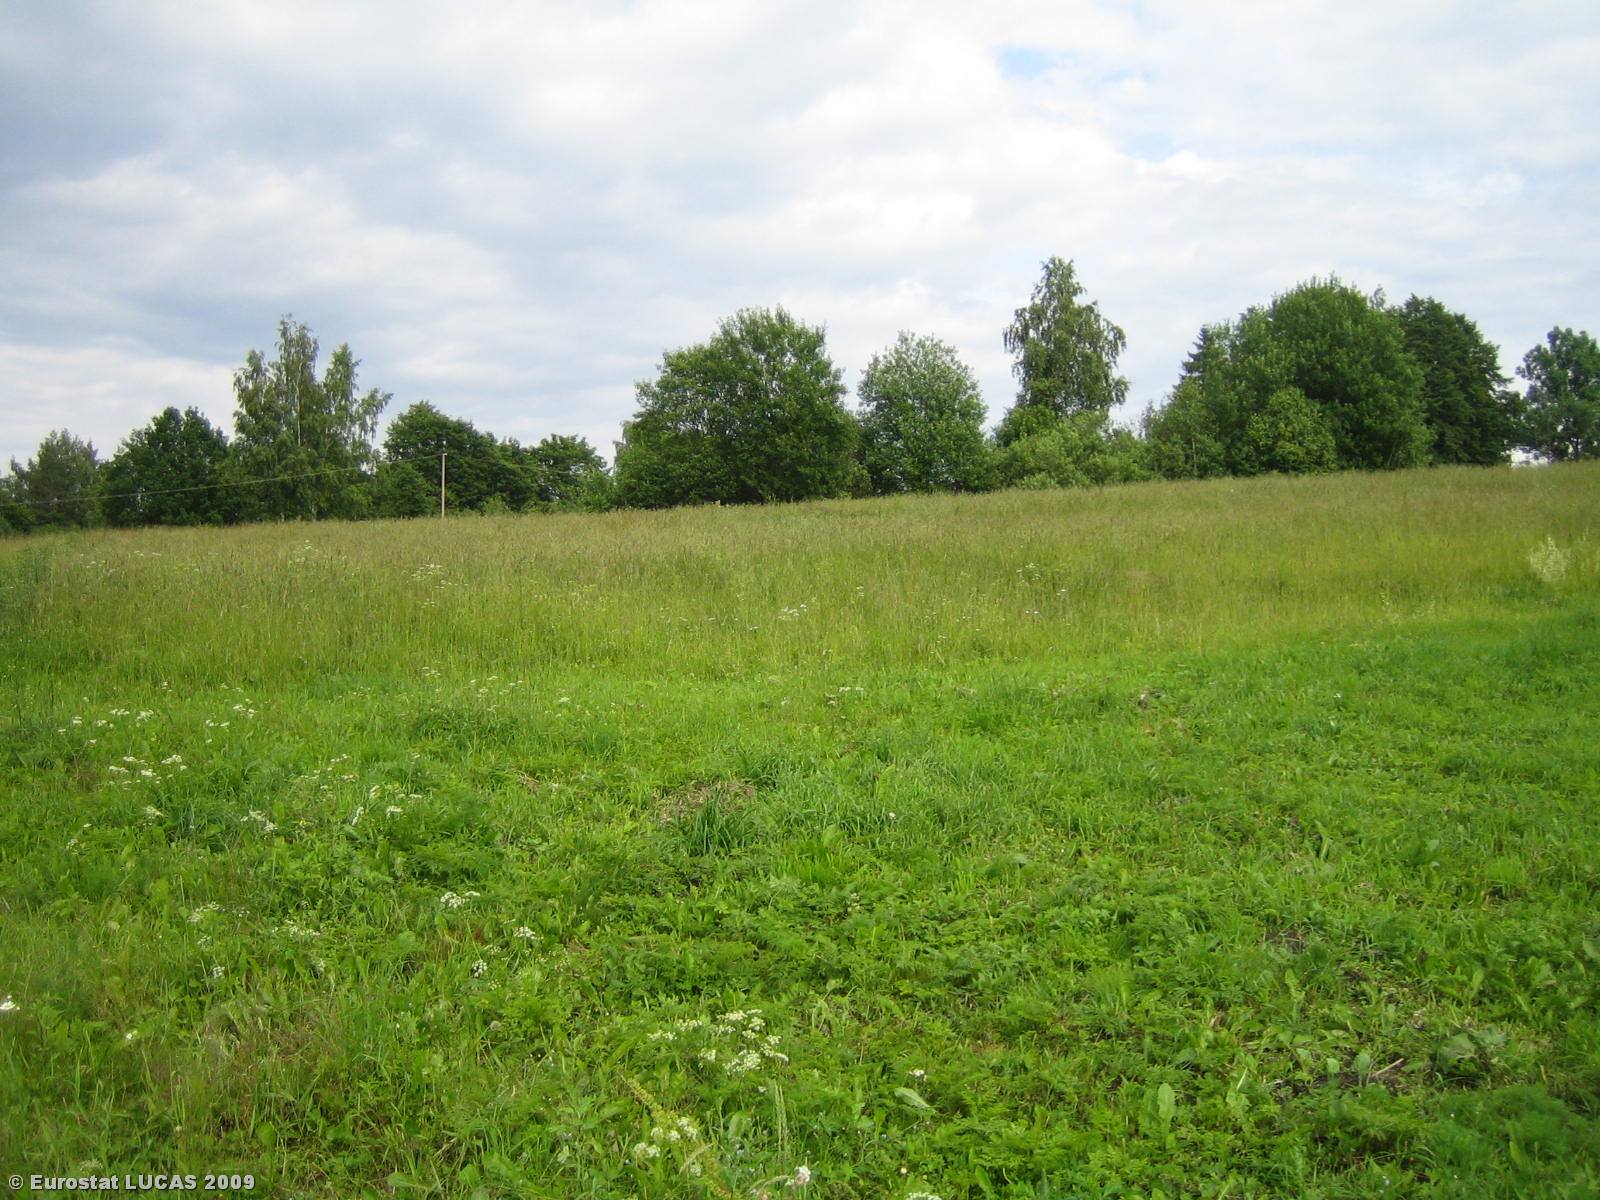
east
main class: Grassland
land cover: Grassland without tree/shrub cover
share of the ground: > 75 %
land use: Agriculture (excluding fallow land and kitchen gardens)
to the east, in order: Grassland without tree/shrub cover; Shrubland with sparse tree cover; Grassland without tree/shrub cover; Paved roads, cycling and walking lanes; Apple fruit; Artificial constructions in urban areas; Single bushes/trees; Grassland without tree/shrub cover; Ditches and canals; Grassland without tree/shrub cover
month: July
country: LT
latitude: 55.5785
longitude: 25.8530
